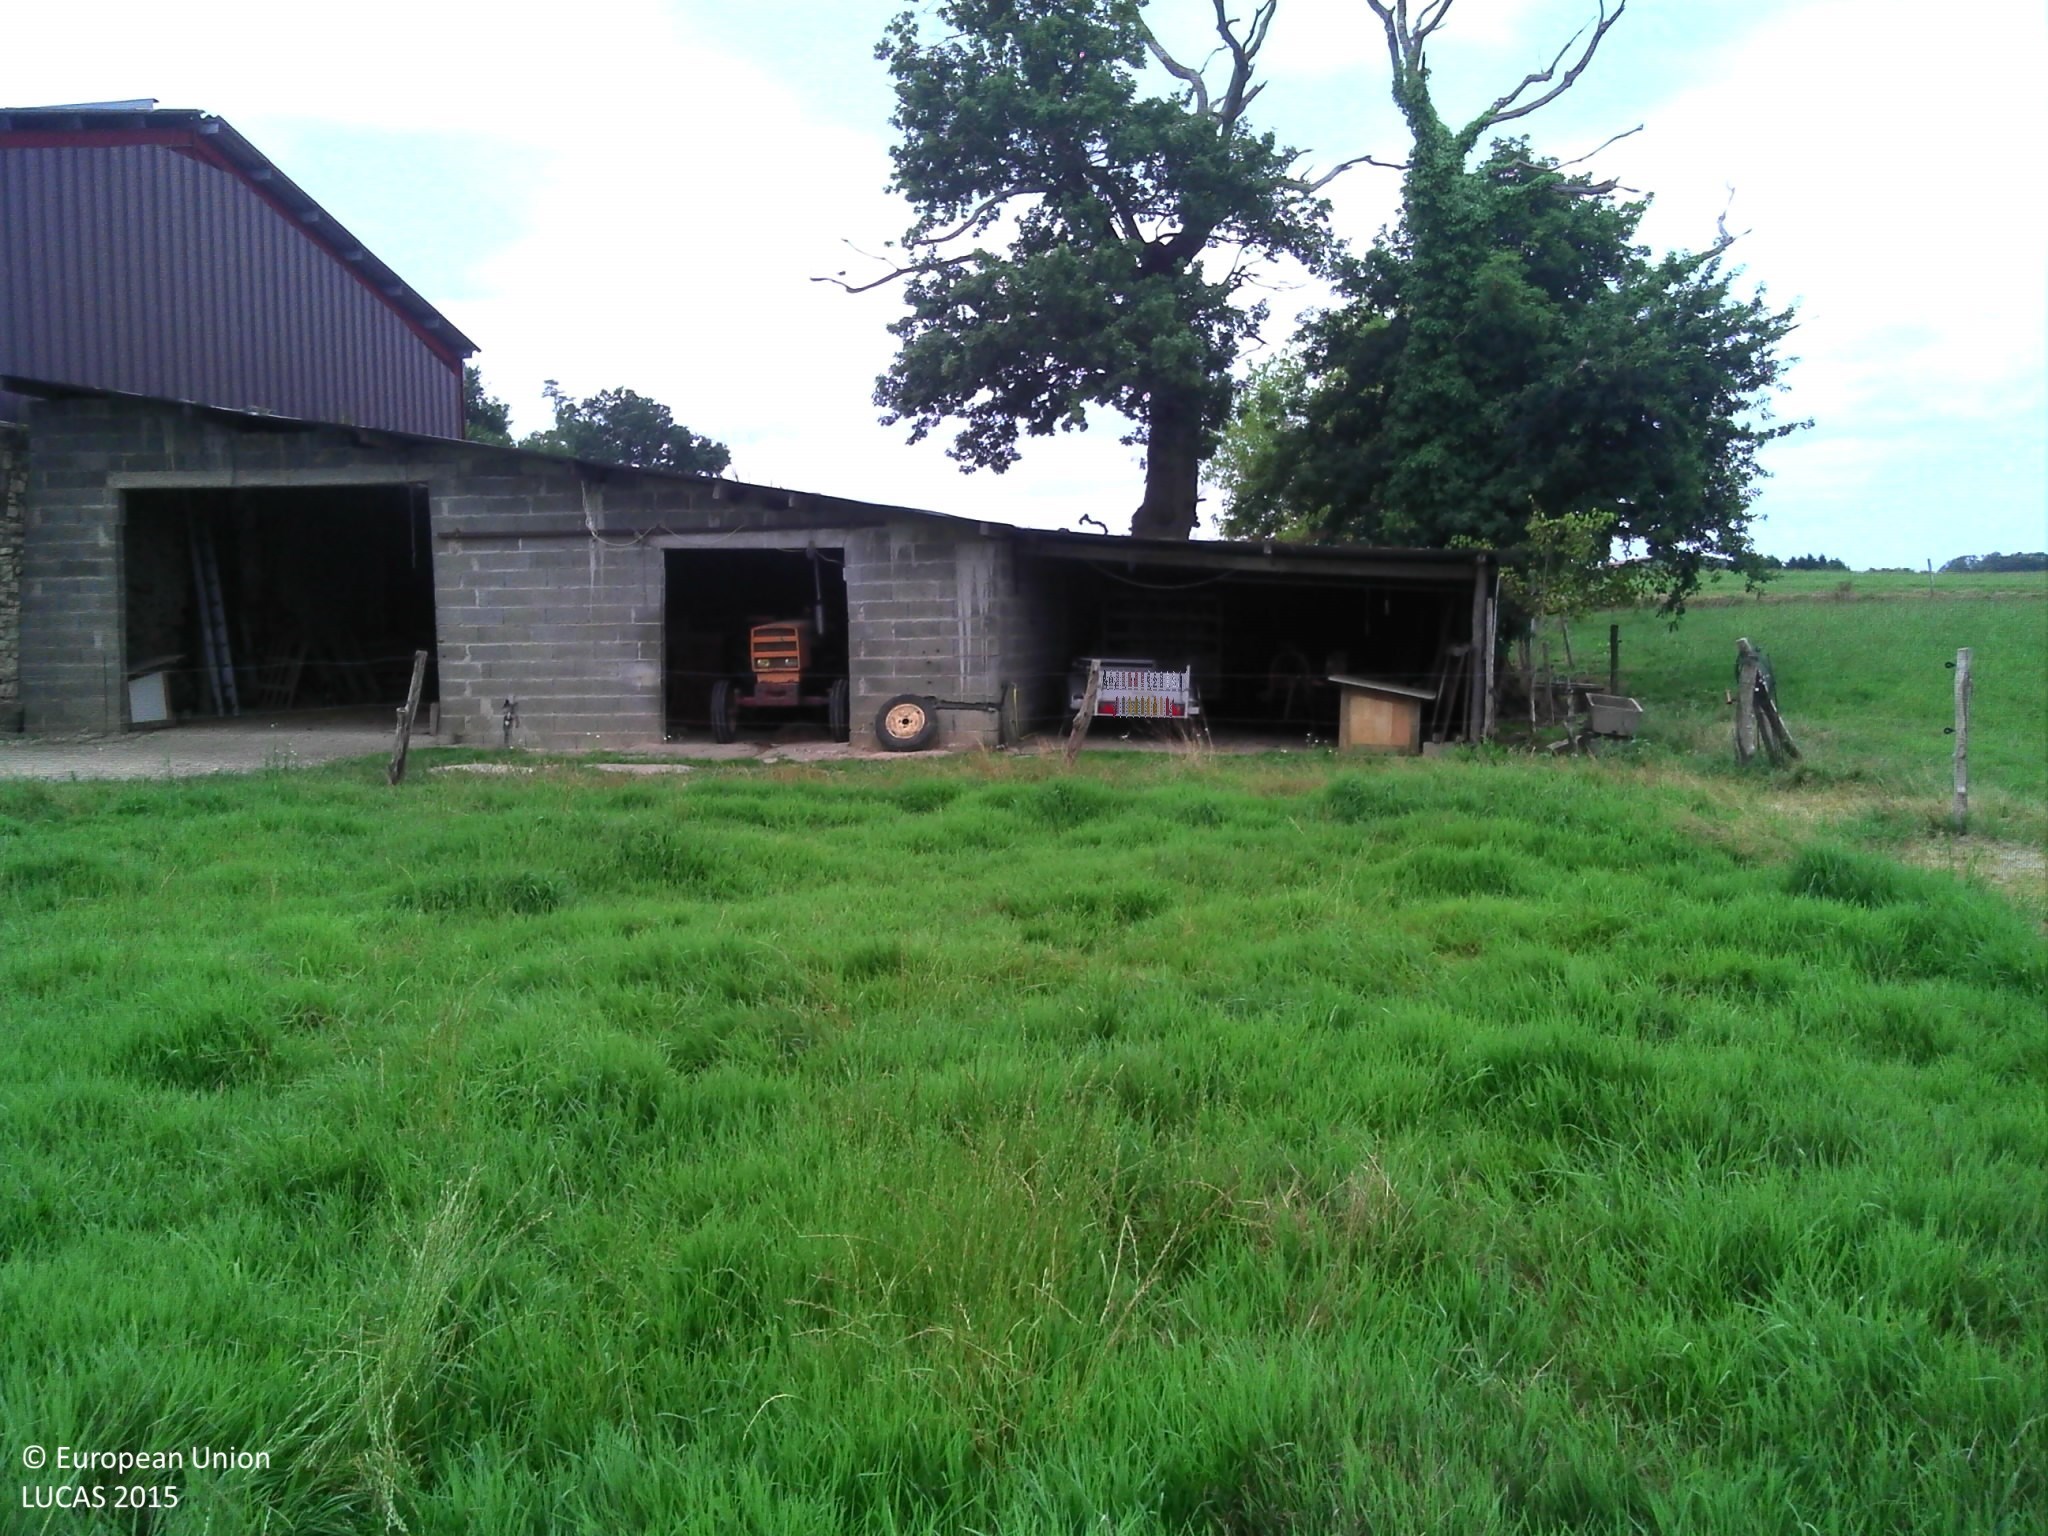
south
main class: Grassland
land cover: Grassland without tree/shrub cover
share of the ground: > 75 %
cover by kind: herbaceous plants 100 %
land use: Agriculture (excluding fallow land and kitchen gardens)
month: August
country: FR
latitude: 43.4976
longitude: -1.1078
